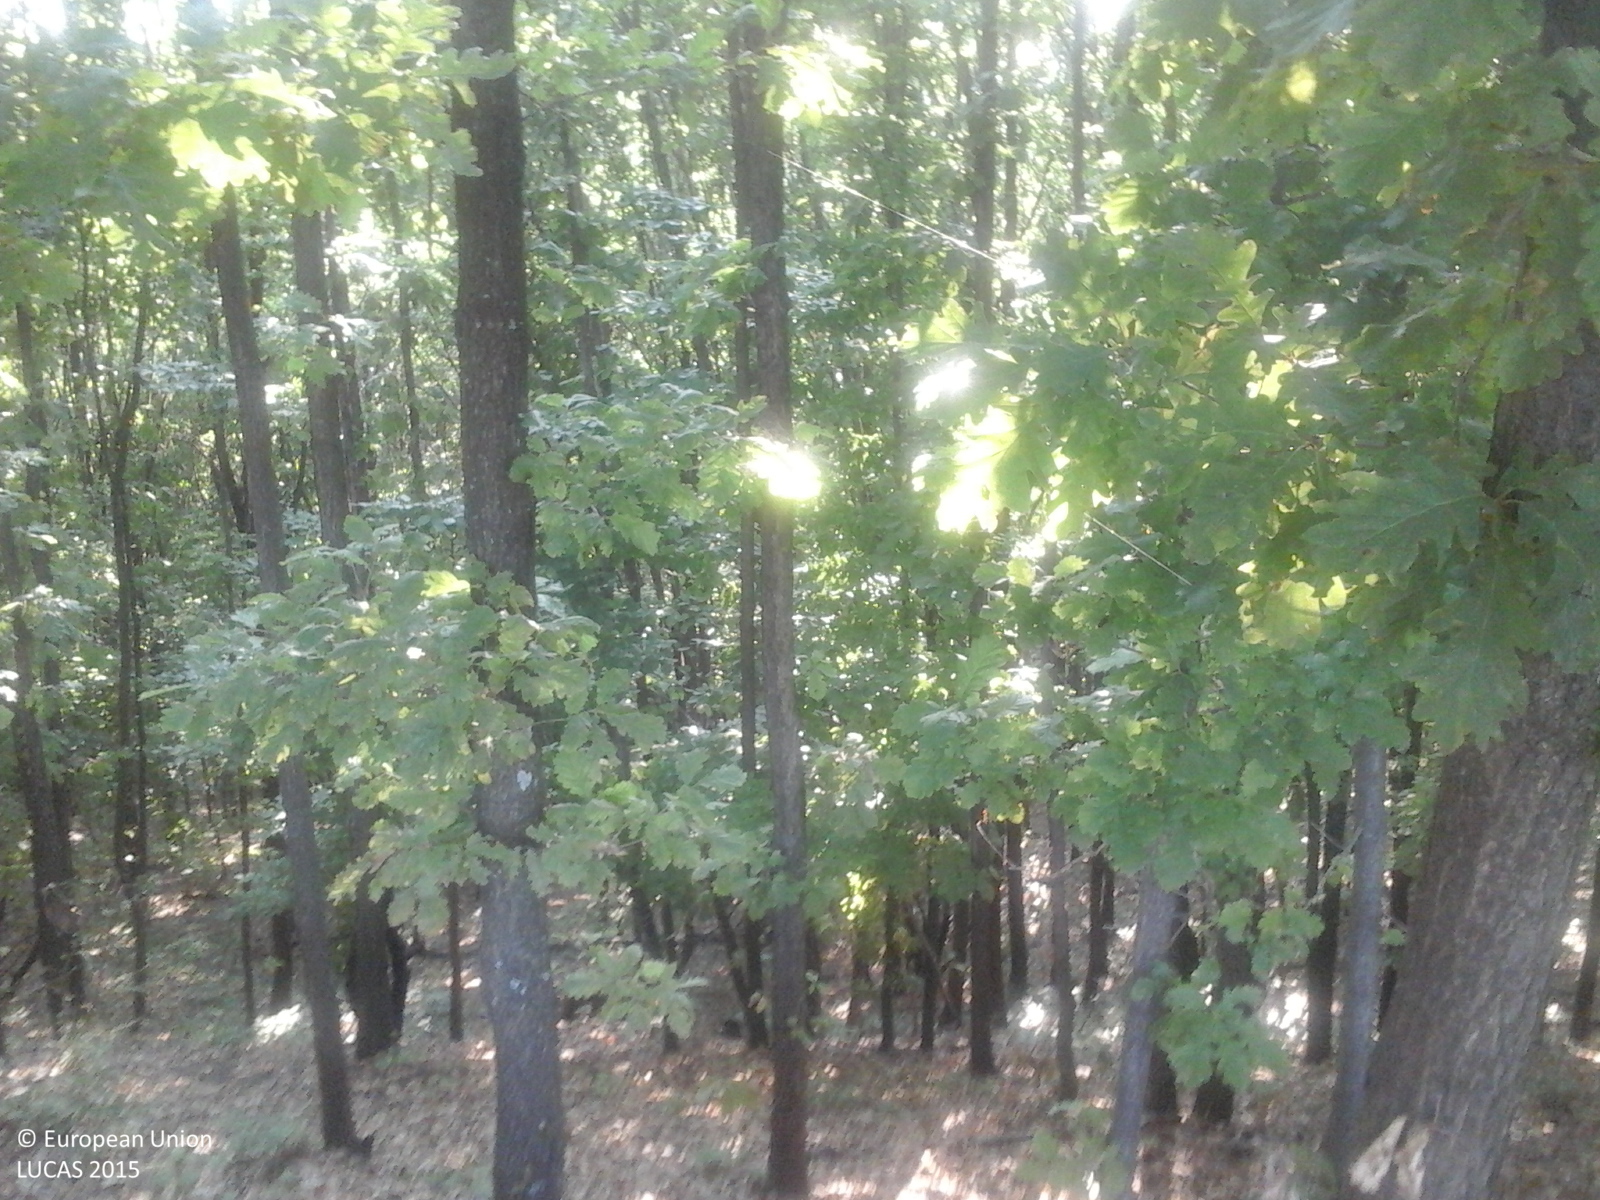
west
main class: Woodland
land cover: Broadleaved woodland
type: acidophilous oak and oak-birch forest
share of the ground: > 75 %
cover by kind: broadleaved forest trees 100 %
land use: Forestry
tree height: > 5 m
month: July
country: RO
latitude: 44.9209
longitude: 24.6076
